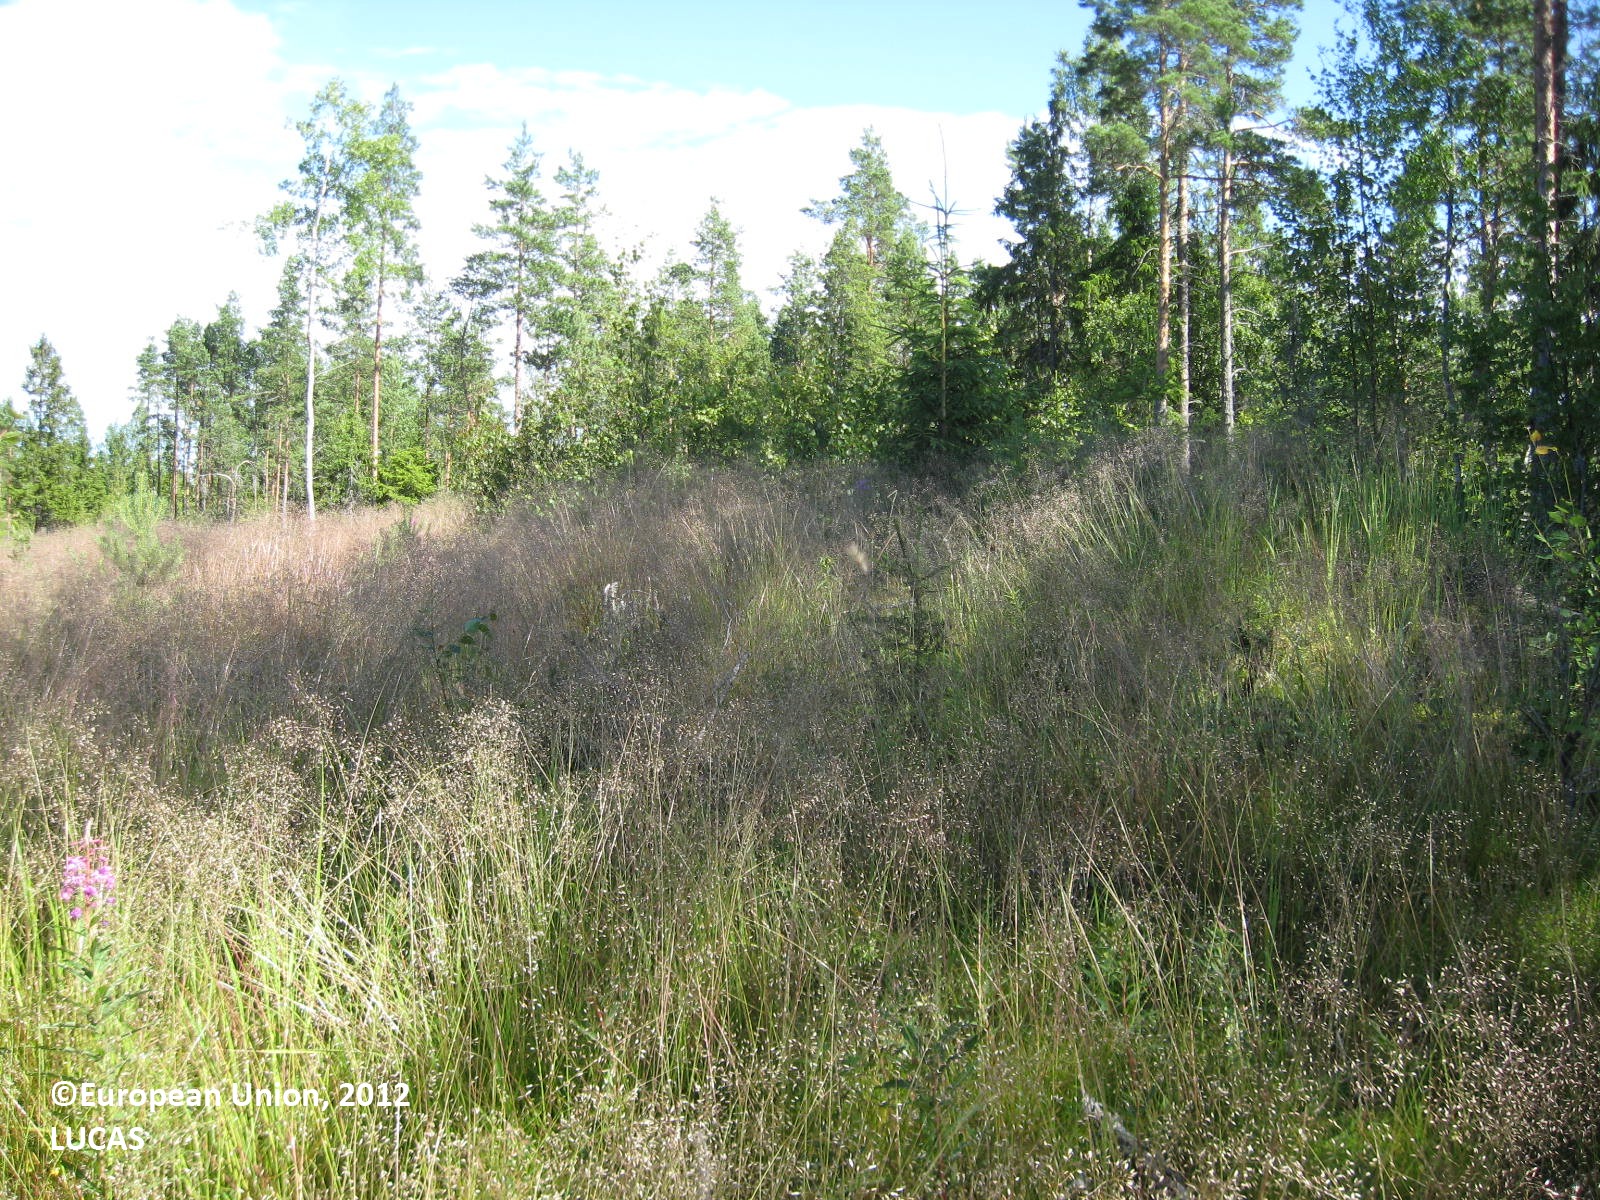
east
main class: Woodland
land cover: Other mixed woodland
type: boreal forest
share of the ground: 10 - 25 %
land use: Forestry
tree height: < 5 m
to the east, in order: Other mixed woodland; Pine dominated coniferous woodland; Other coniferous woodland; Ditches and canals; Other mixed woodland; Ditches and canals; Broadleaved woodland; Ditches and canals; Other mixed woodland
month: July
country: FI
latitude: 62.0987
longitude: 21.4821
